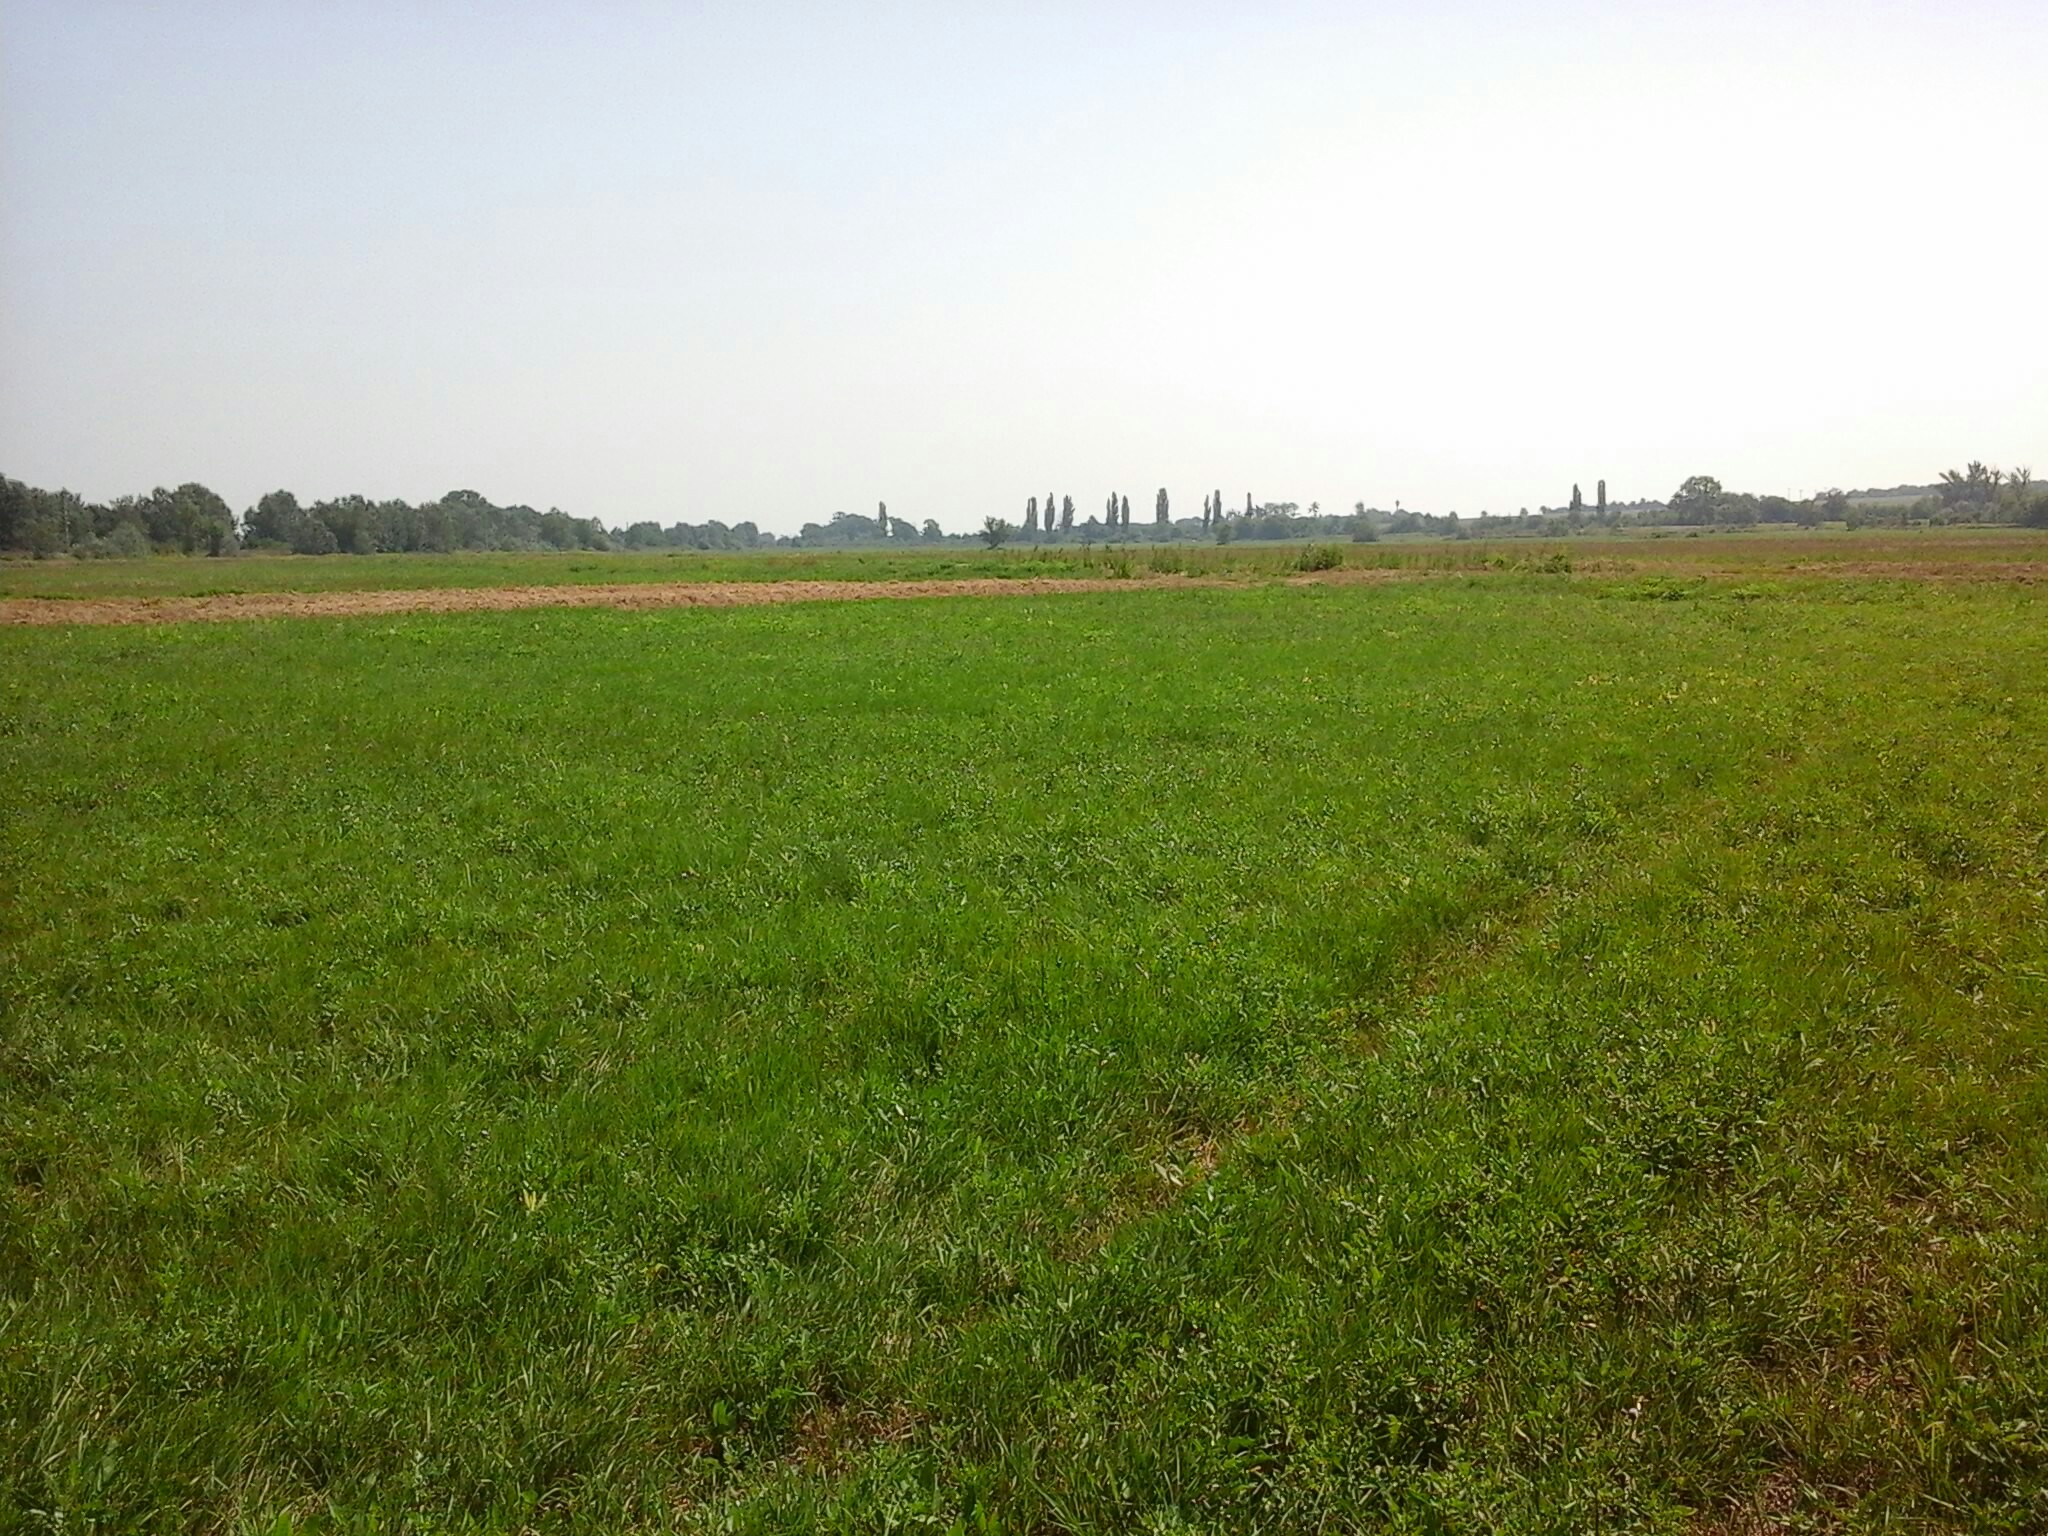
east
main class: Grassland
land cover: Grassland without tree/shrub cover
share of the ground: > 75 %
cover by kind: herbaceous plants 100 %
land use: Agriculture (excluding fallow land and kitchen gardens)
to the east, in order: Grassland without tree/shrub cover; Ditches and canals; Tracks; Grassland without tree/shrub cover; Ditches and canals; Grassland without tree/shrub cover
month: August
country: HU
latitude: 47.1697
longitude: 18.2833
